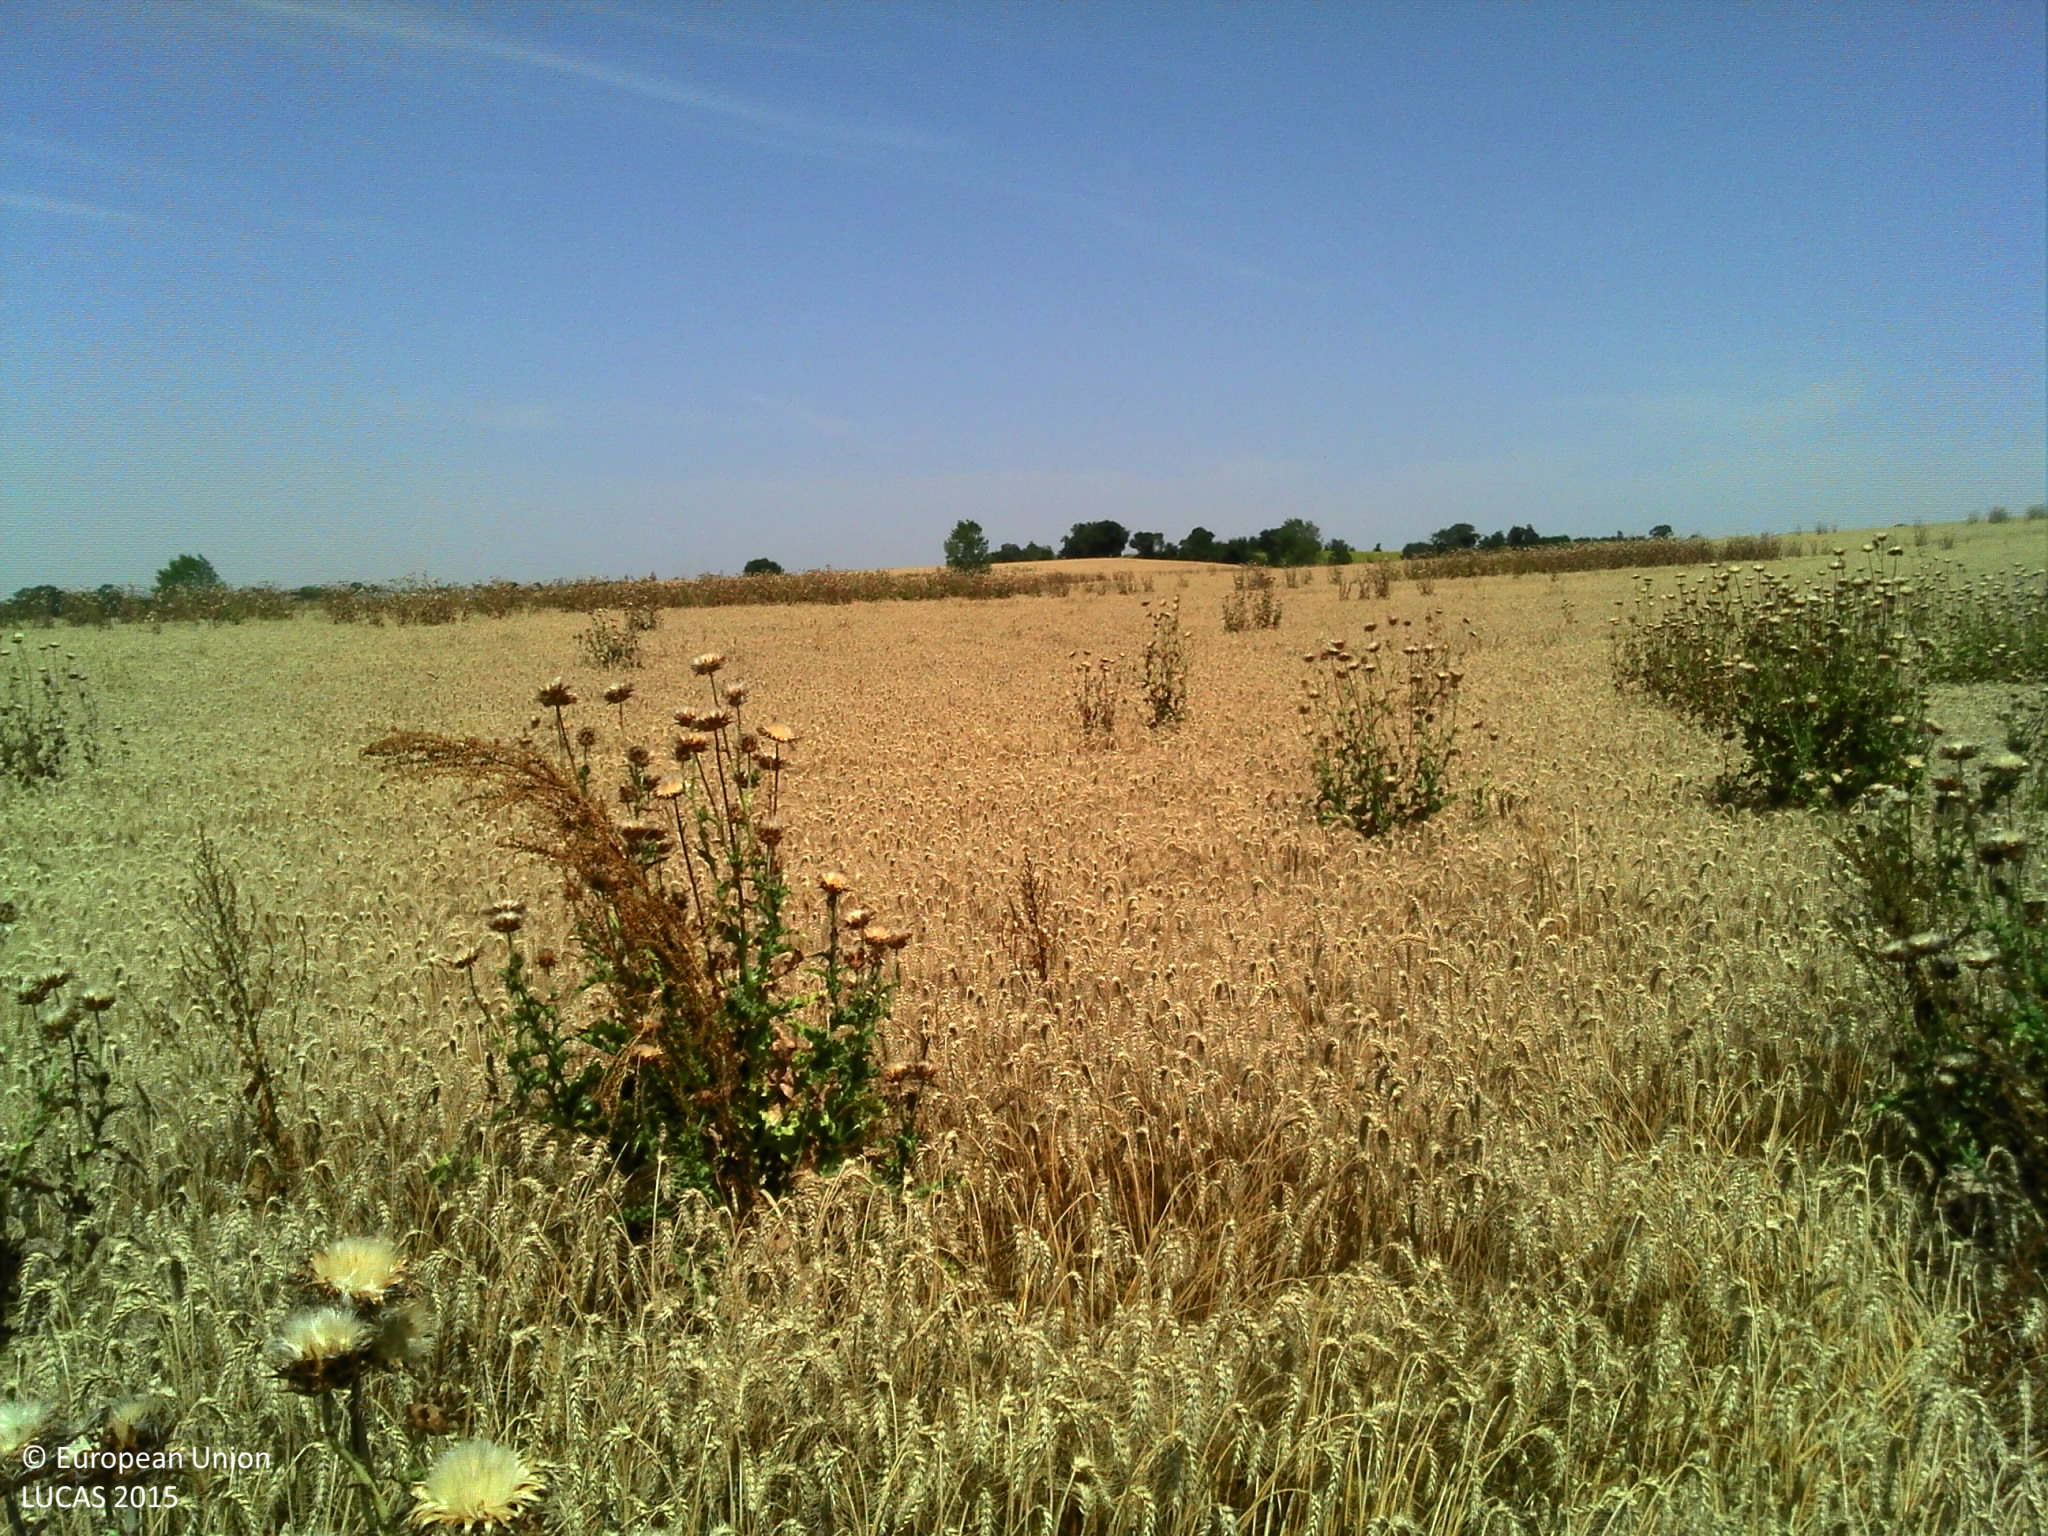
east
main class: Cropland
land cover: Common wheat
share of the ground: > 75 %
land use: Agriculture (excluding fallow land and kitchen gardens)
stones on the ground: < 10 %
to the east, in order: Common wheat
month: July
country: FR
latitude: 43.5418
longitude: 1.0034
